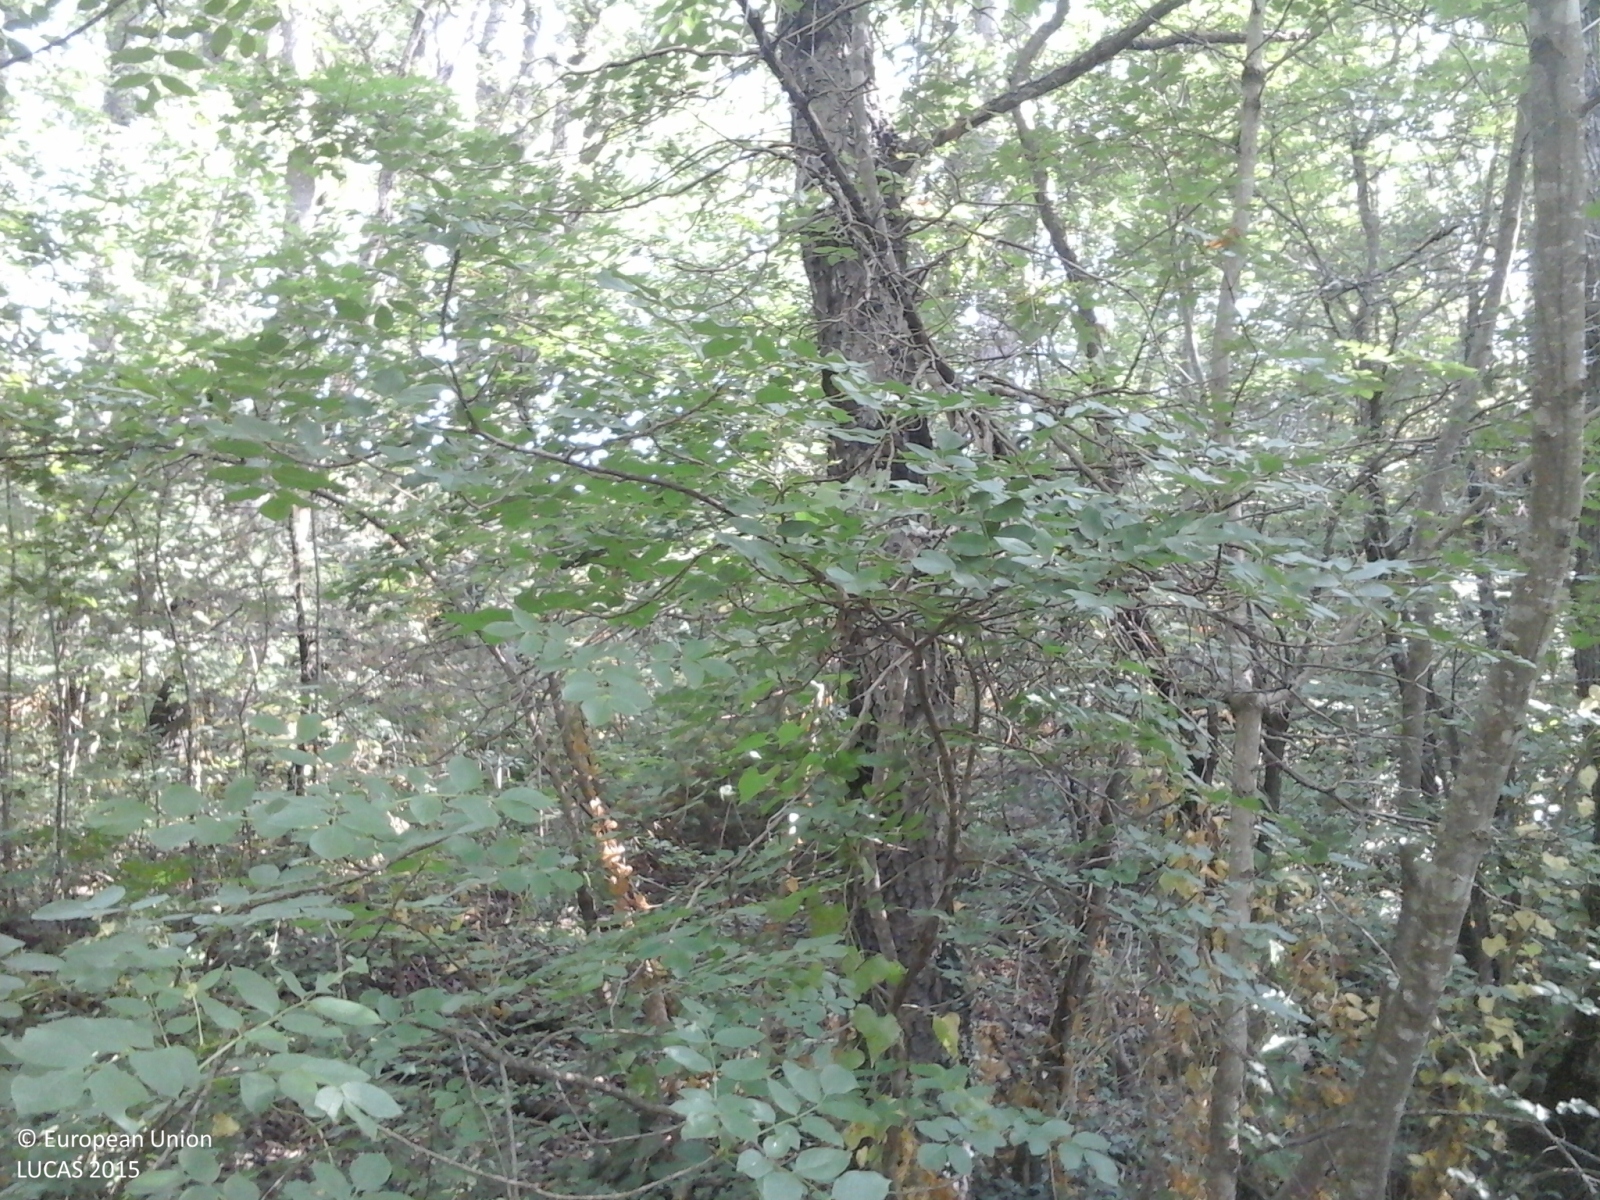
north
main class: Woodland
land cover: Broadleaved woodland
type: thermophilous deciduous forest
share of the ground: > 75 %
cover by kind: broadleaved forest trees 100 %
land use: Forestry
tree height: > 5 m
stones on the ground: < 10 %
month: July
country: IT
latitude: 44.4405
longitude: 10.2382
